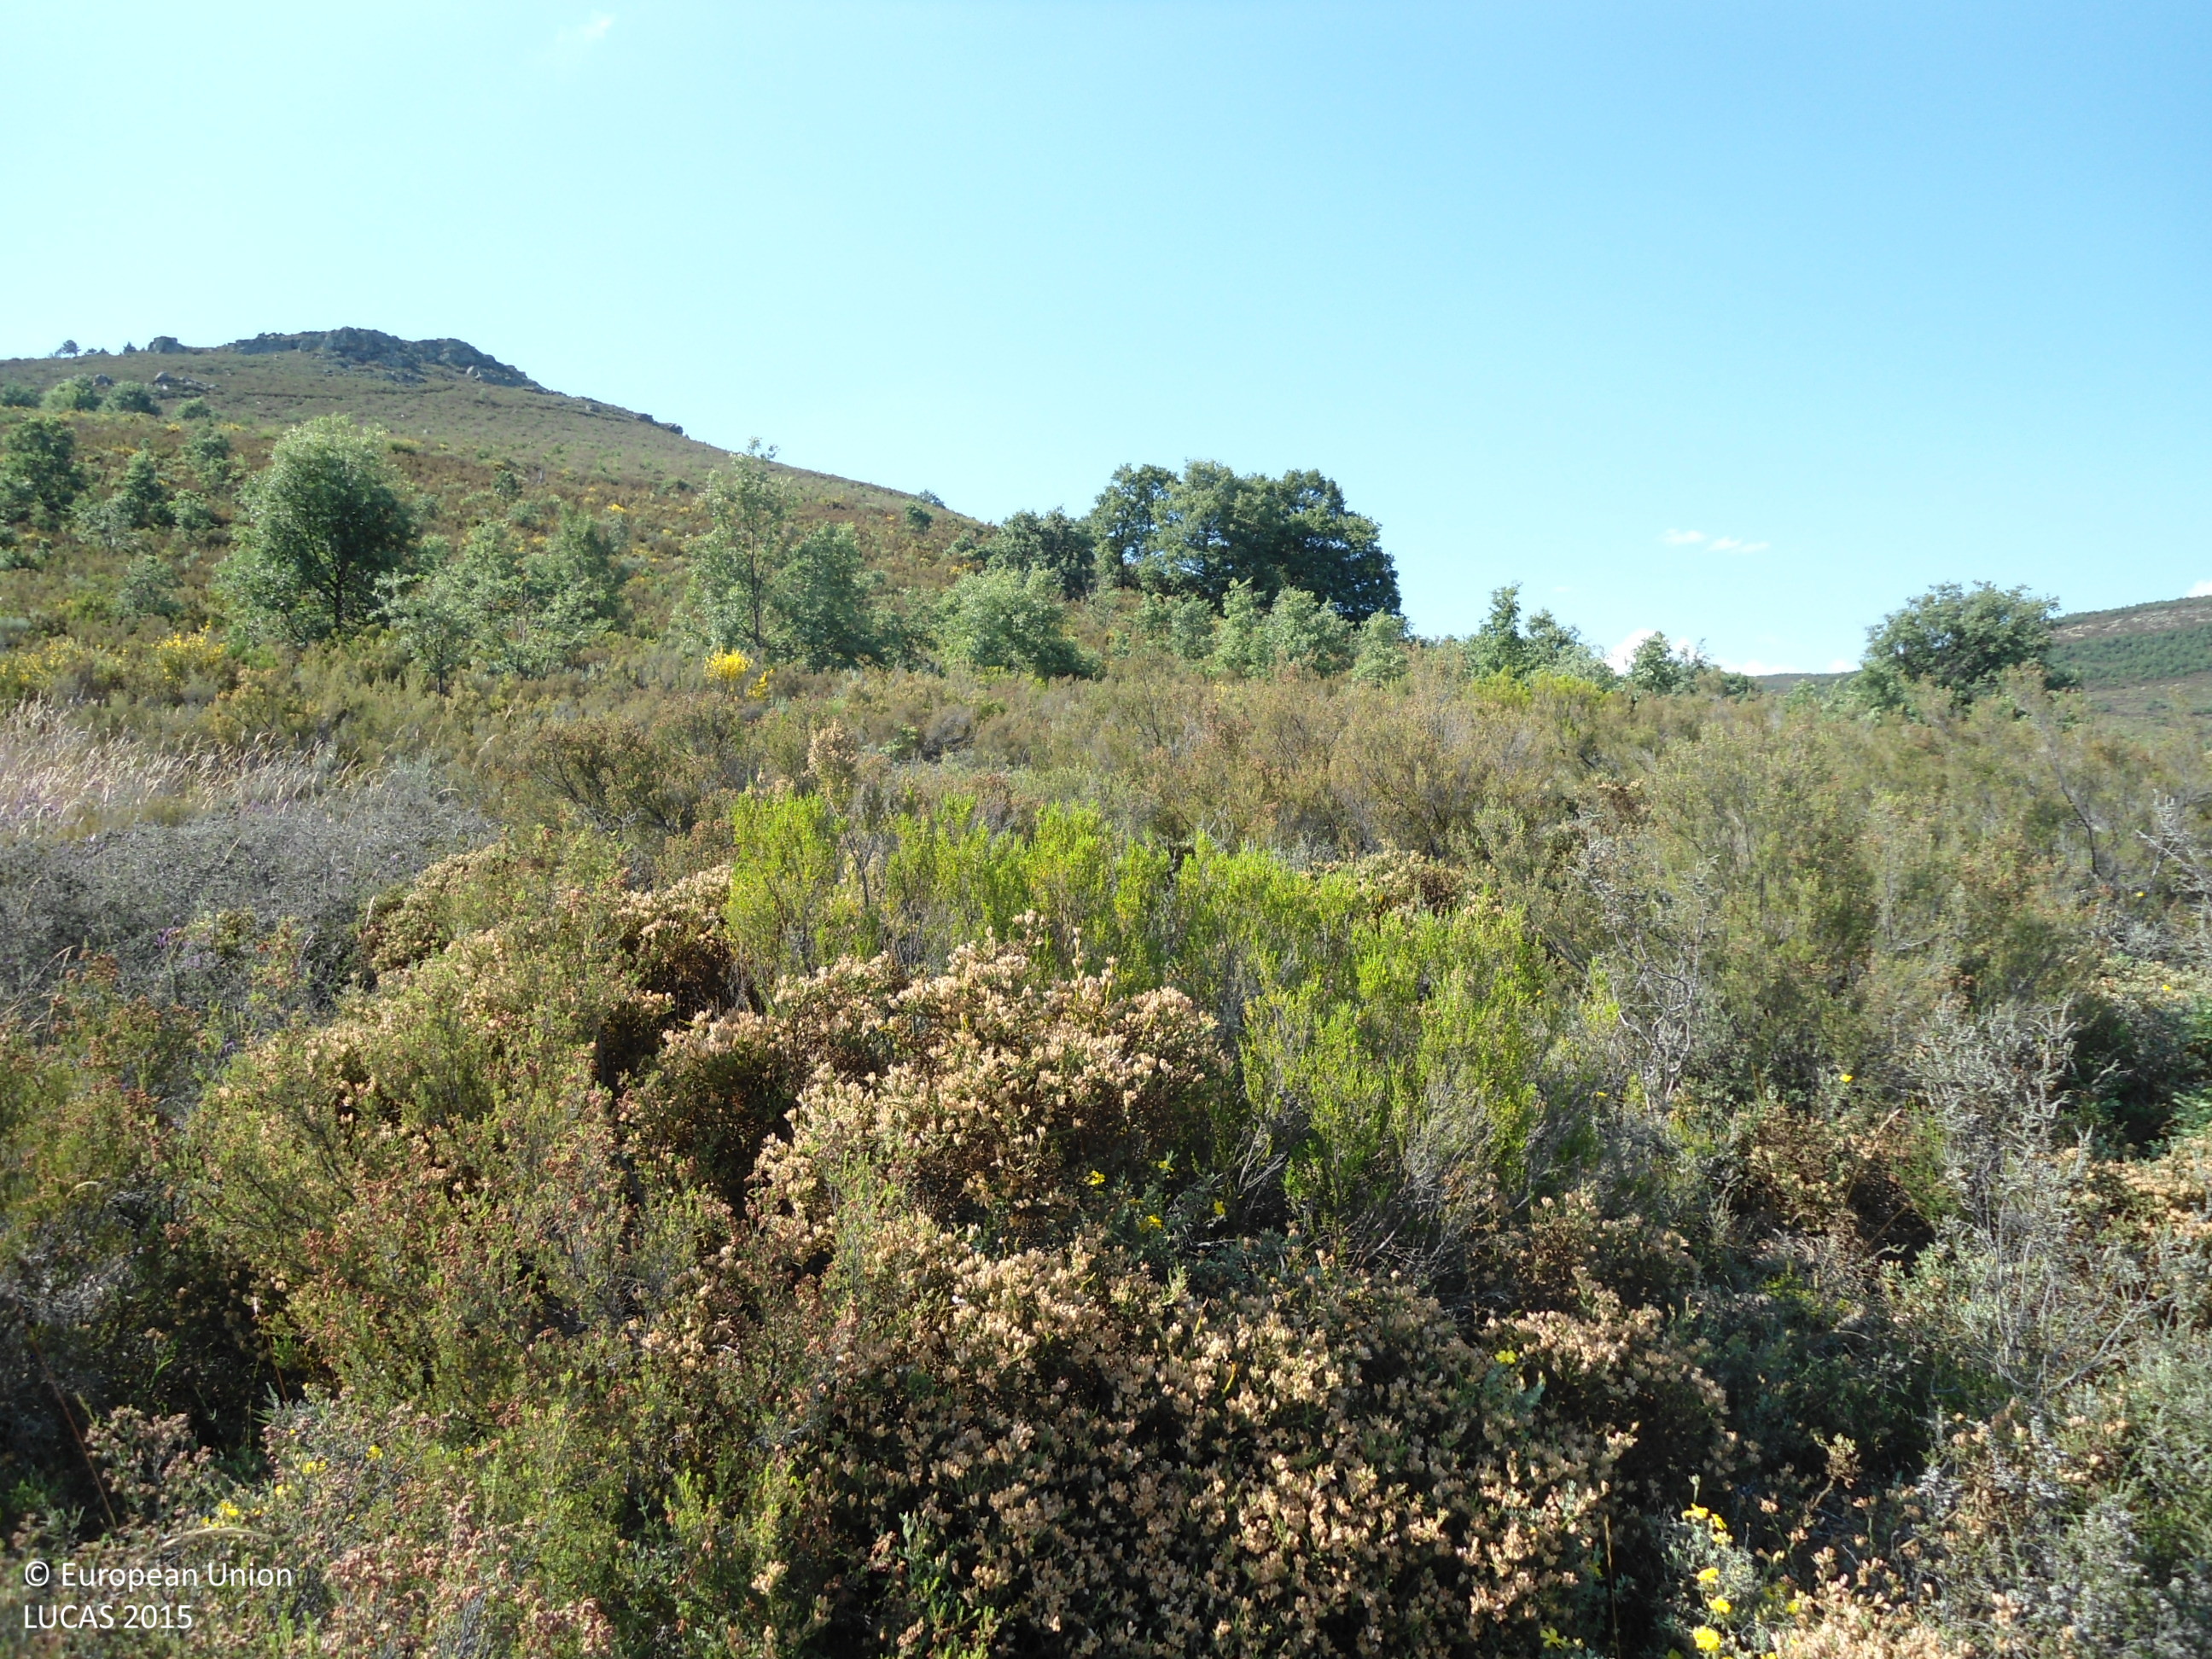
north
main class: Shrubland
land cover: Shrubland with sparse tree cover
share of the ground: > 75 %
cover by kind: shrubs 95 %, broadleaved forest trees 5 %
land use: Semi-natural and natural areas not in use
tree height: > 5 m
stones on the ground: > 50 %
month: June
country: ES
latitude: 42.1332
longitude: -6.4056
